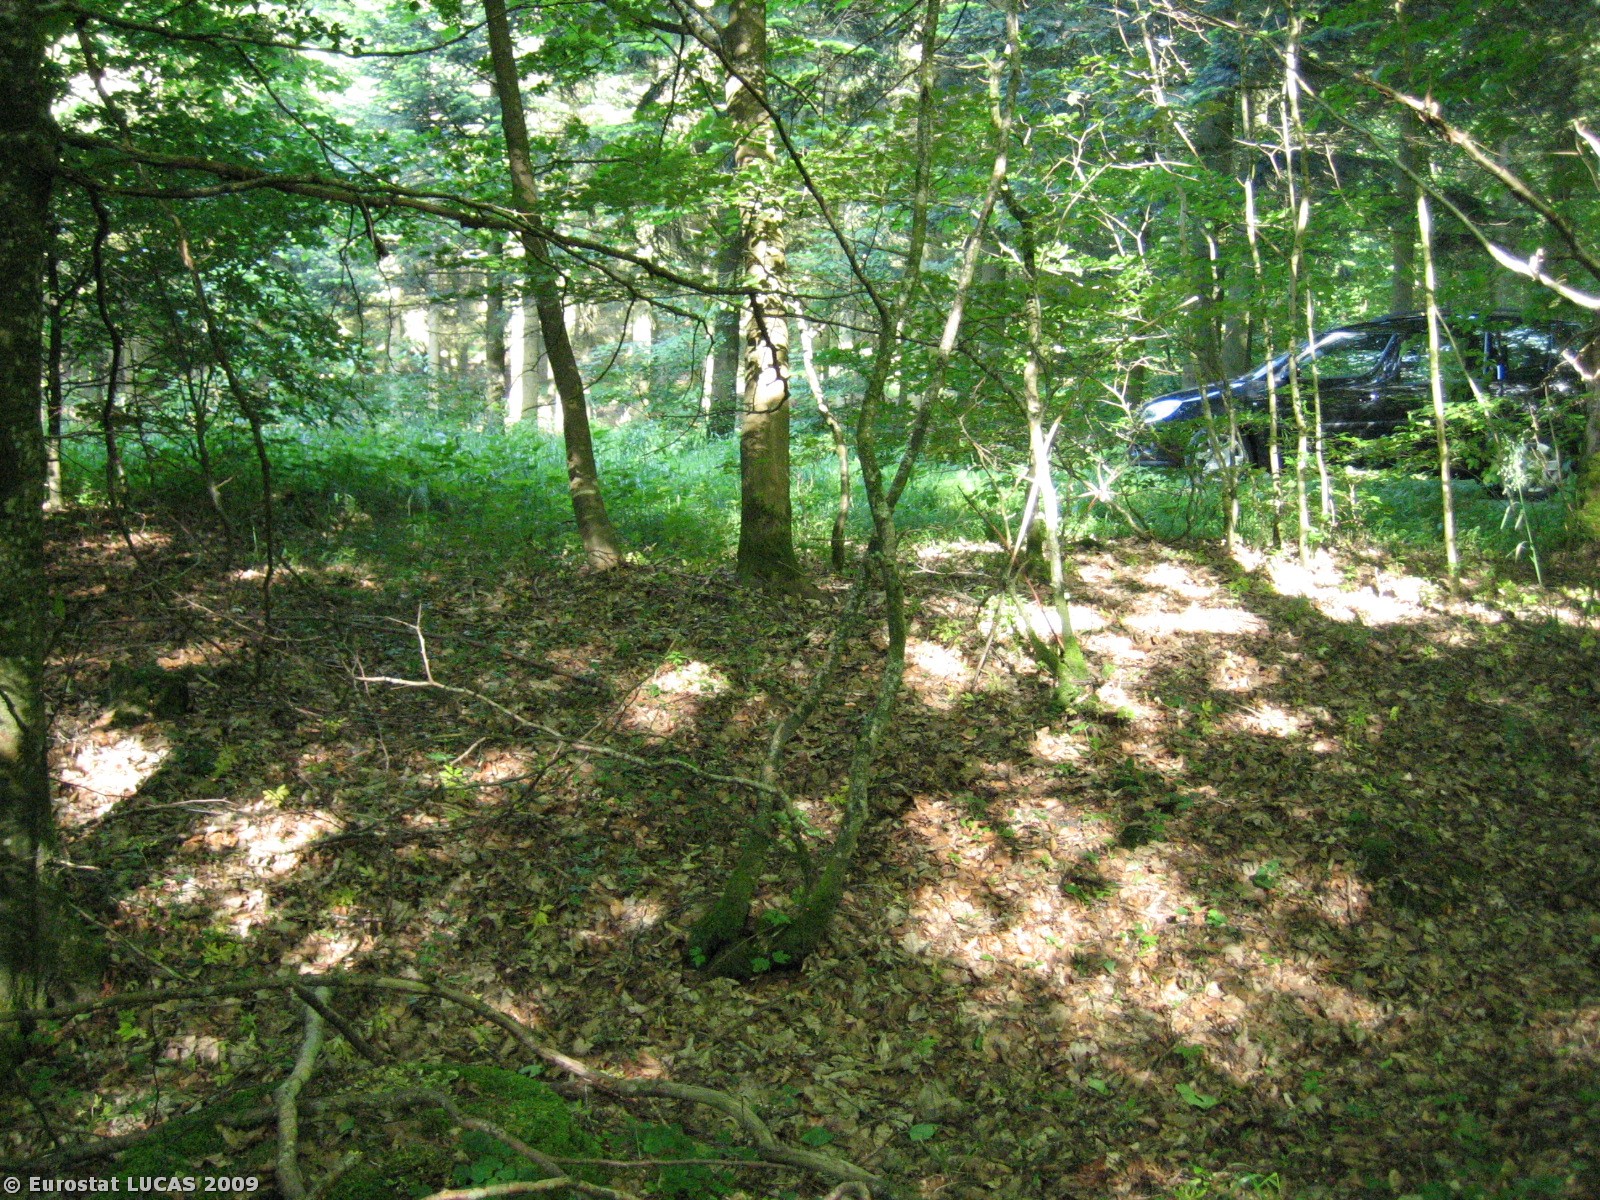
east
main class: Woodland
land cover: Broadleaved woodland
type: mesophytic deciduous forest
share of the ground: > 75 %
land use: Forestry
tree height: > 5 m
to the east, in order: Broadleaved woodland; Tracks; Coniferous woodland; Shrubland with sparse tree cover; Coniferous woodland
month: June
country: DK
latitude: 55.8101
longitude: 9.7928
